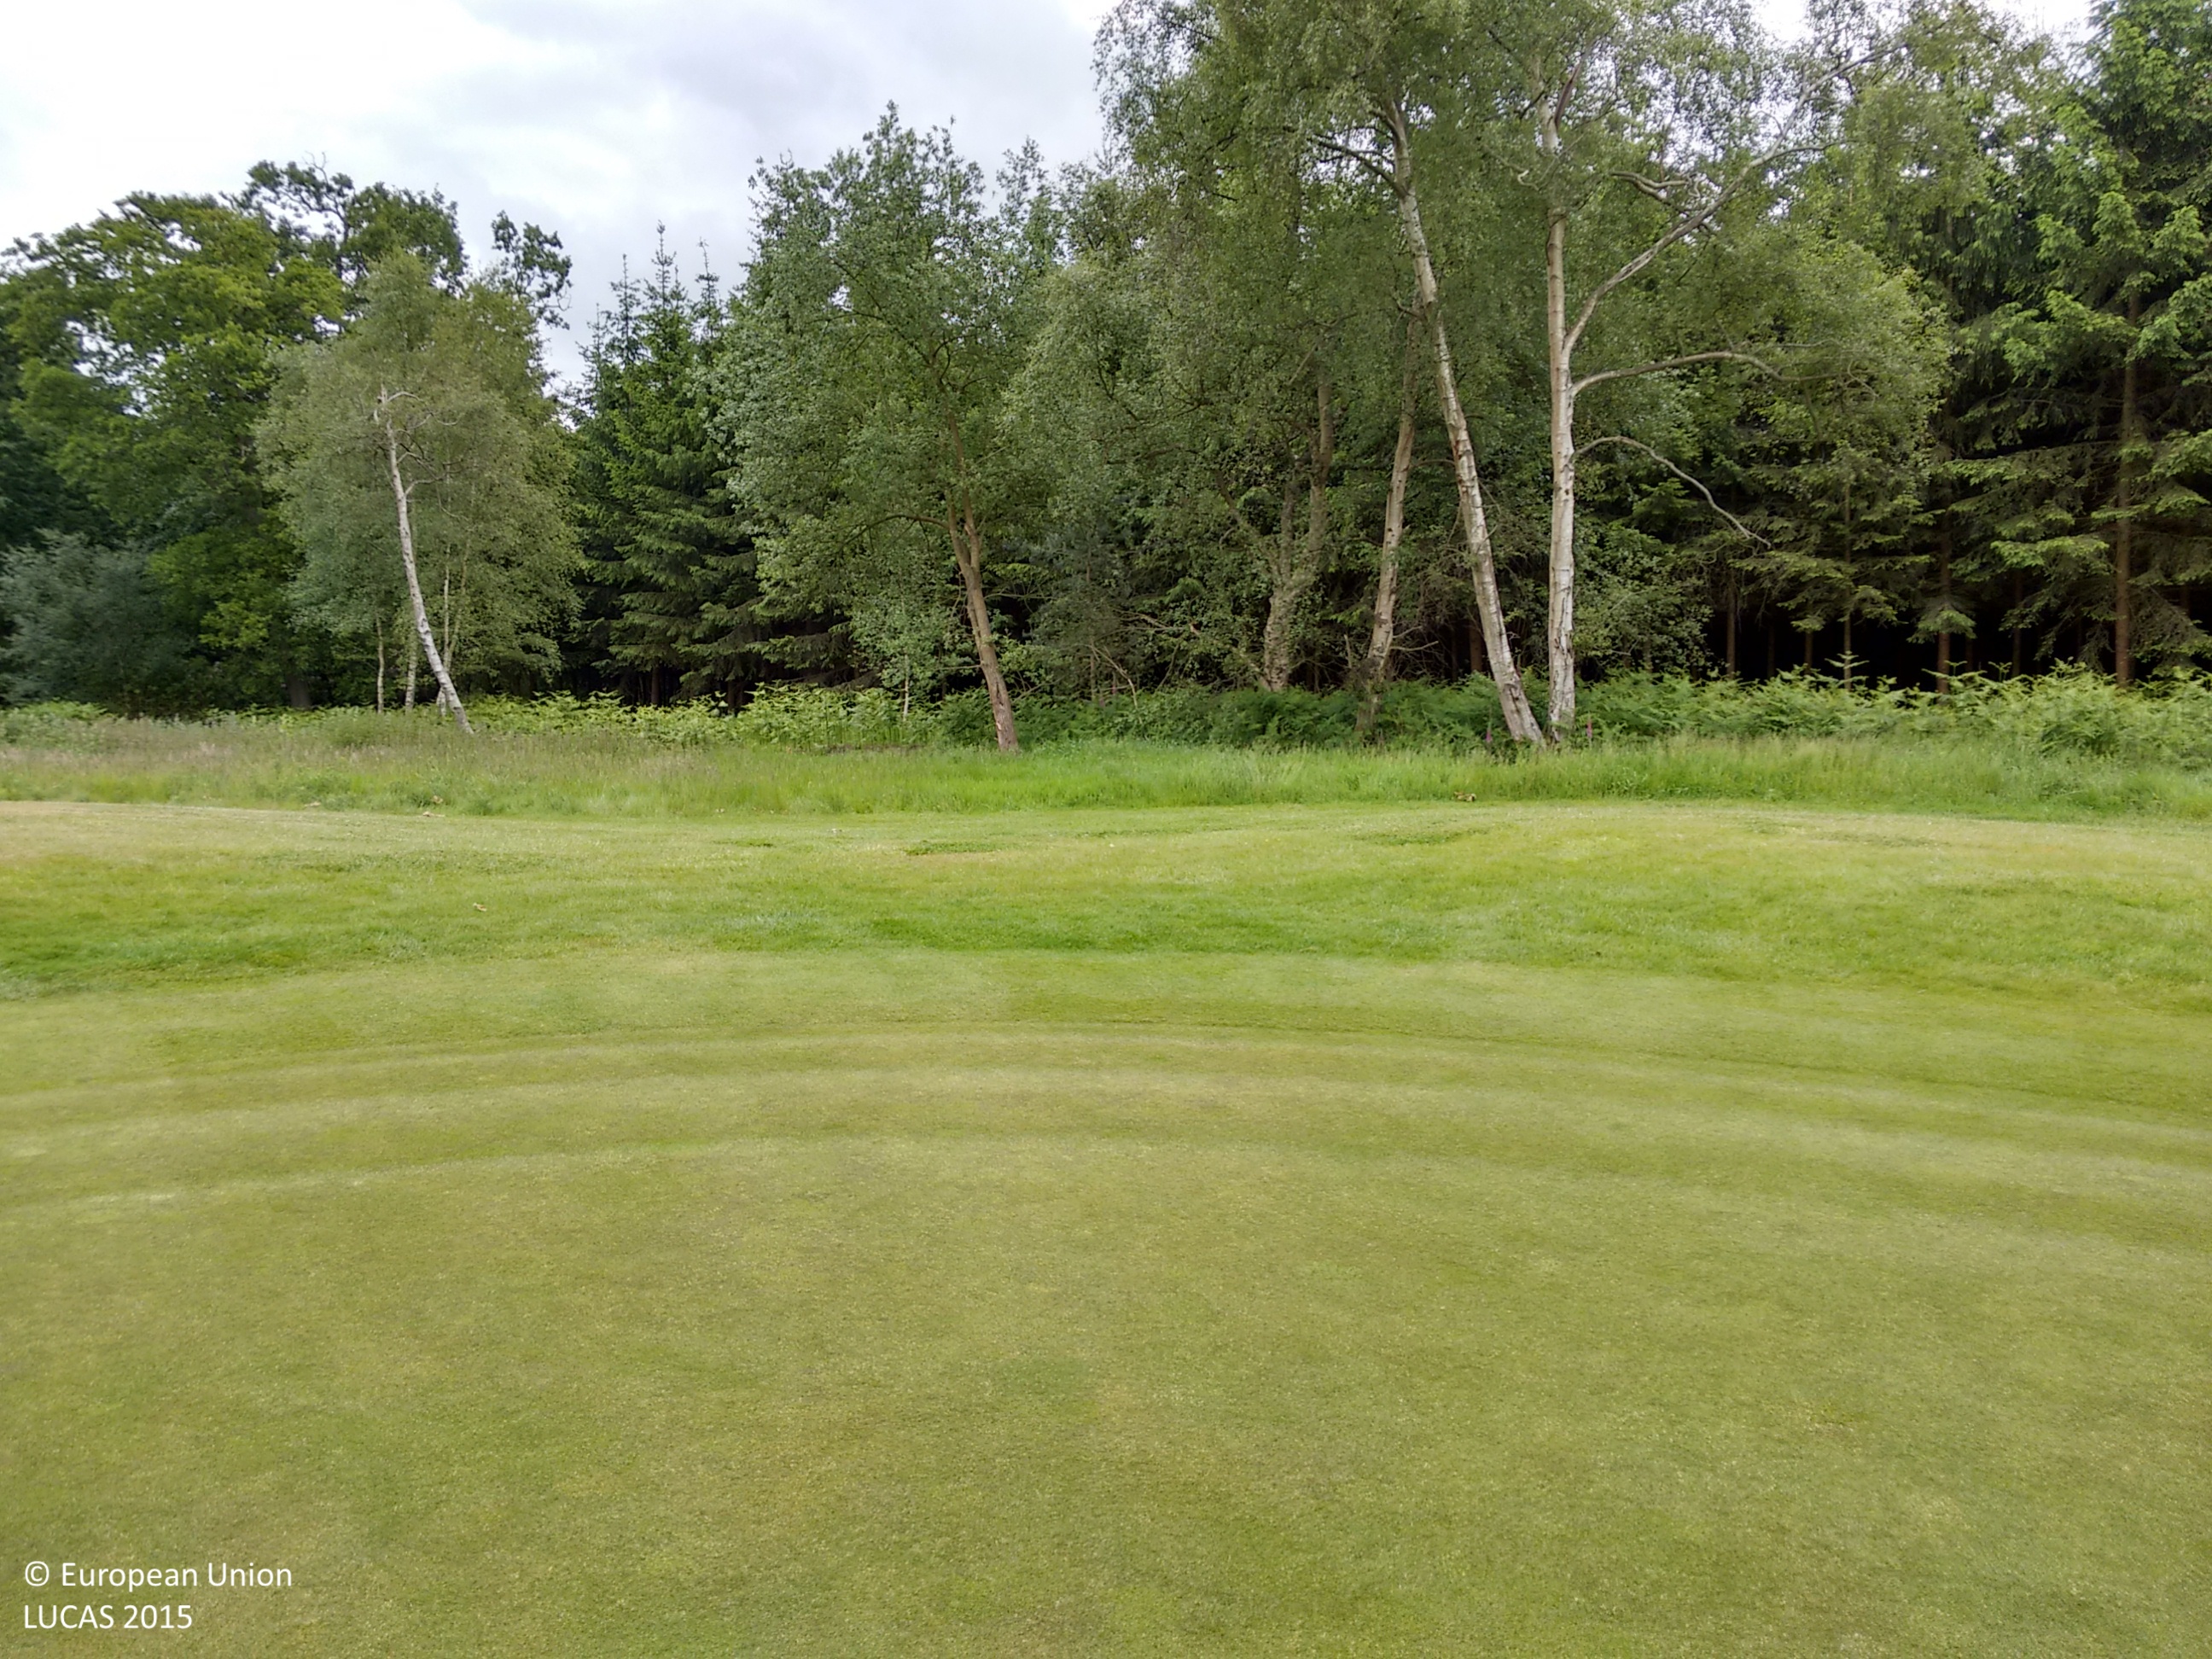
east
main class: Grassland
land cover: Grassland without tree/shrub cover
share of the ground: > 75 %
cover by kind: herbaceous plants 100 %
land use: Amenities, museums, leisure
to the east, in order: Grassland without tree/shrub cover; Ditches and canals; Groves; Spruce dominated coniferous woodland; Ditches and canals; Spruce dominated coniferous woodland; Ditches and canals; Groves; Grassland without tree/shrub cover
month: June
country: GB
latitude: 51.4237
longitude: -0.6682
